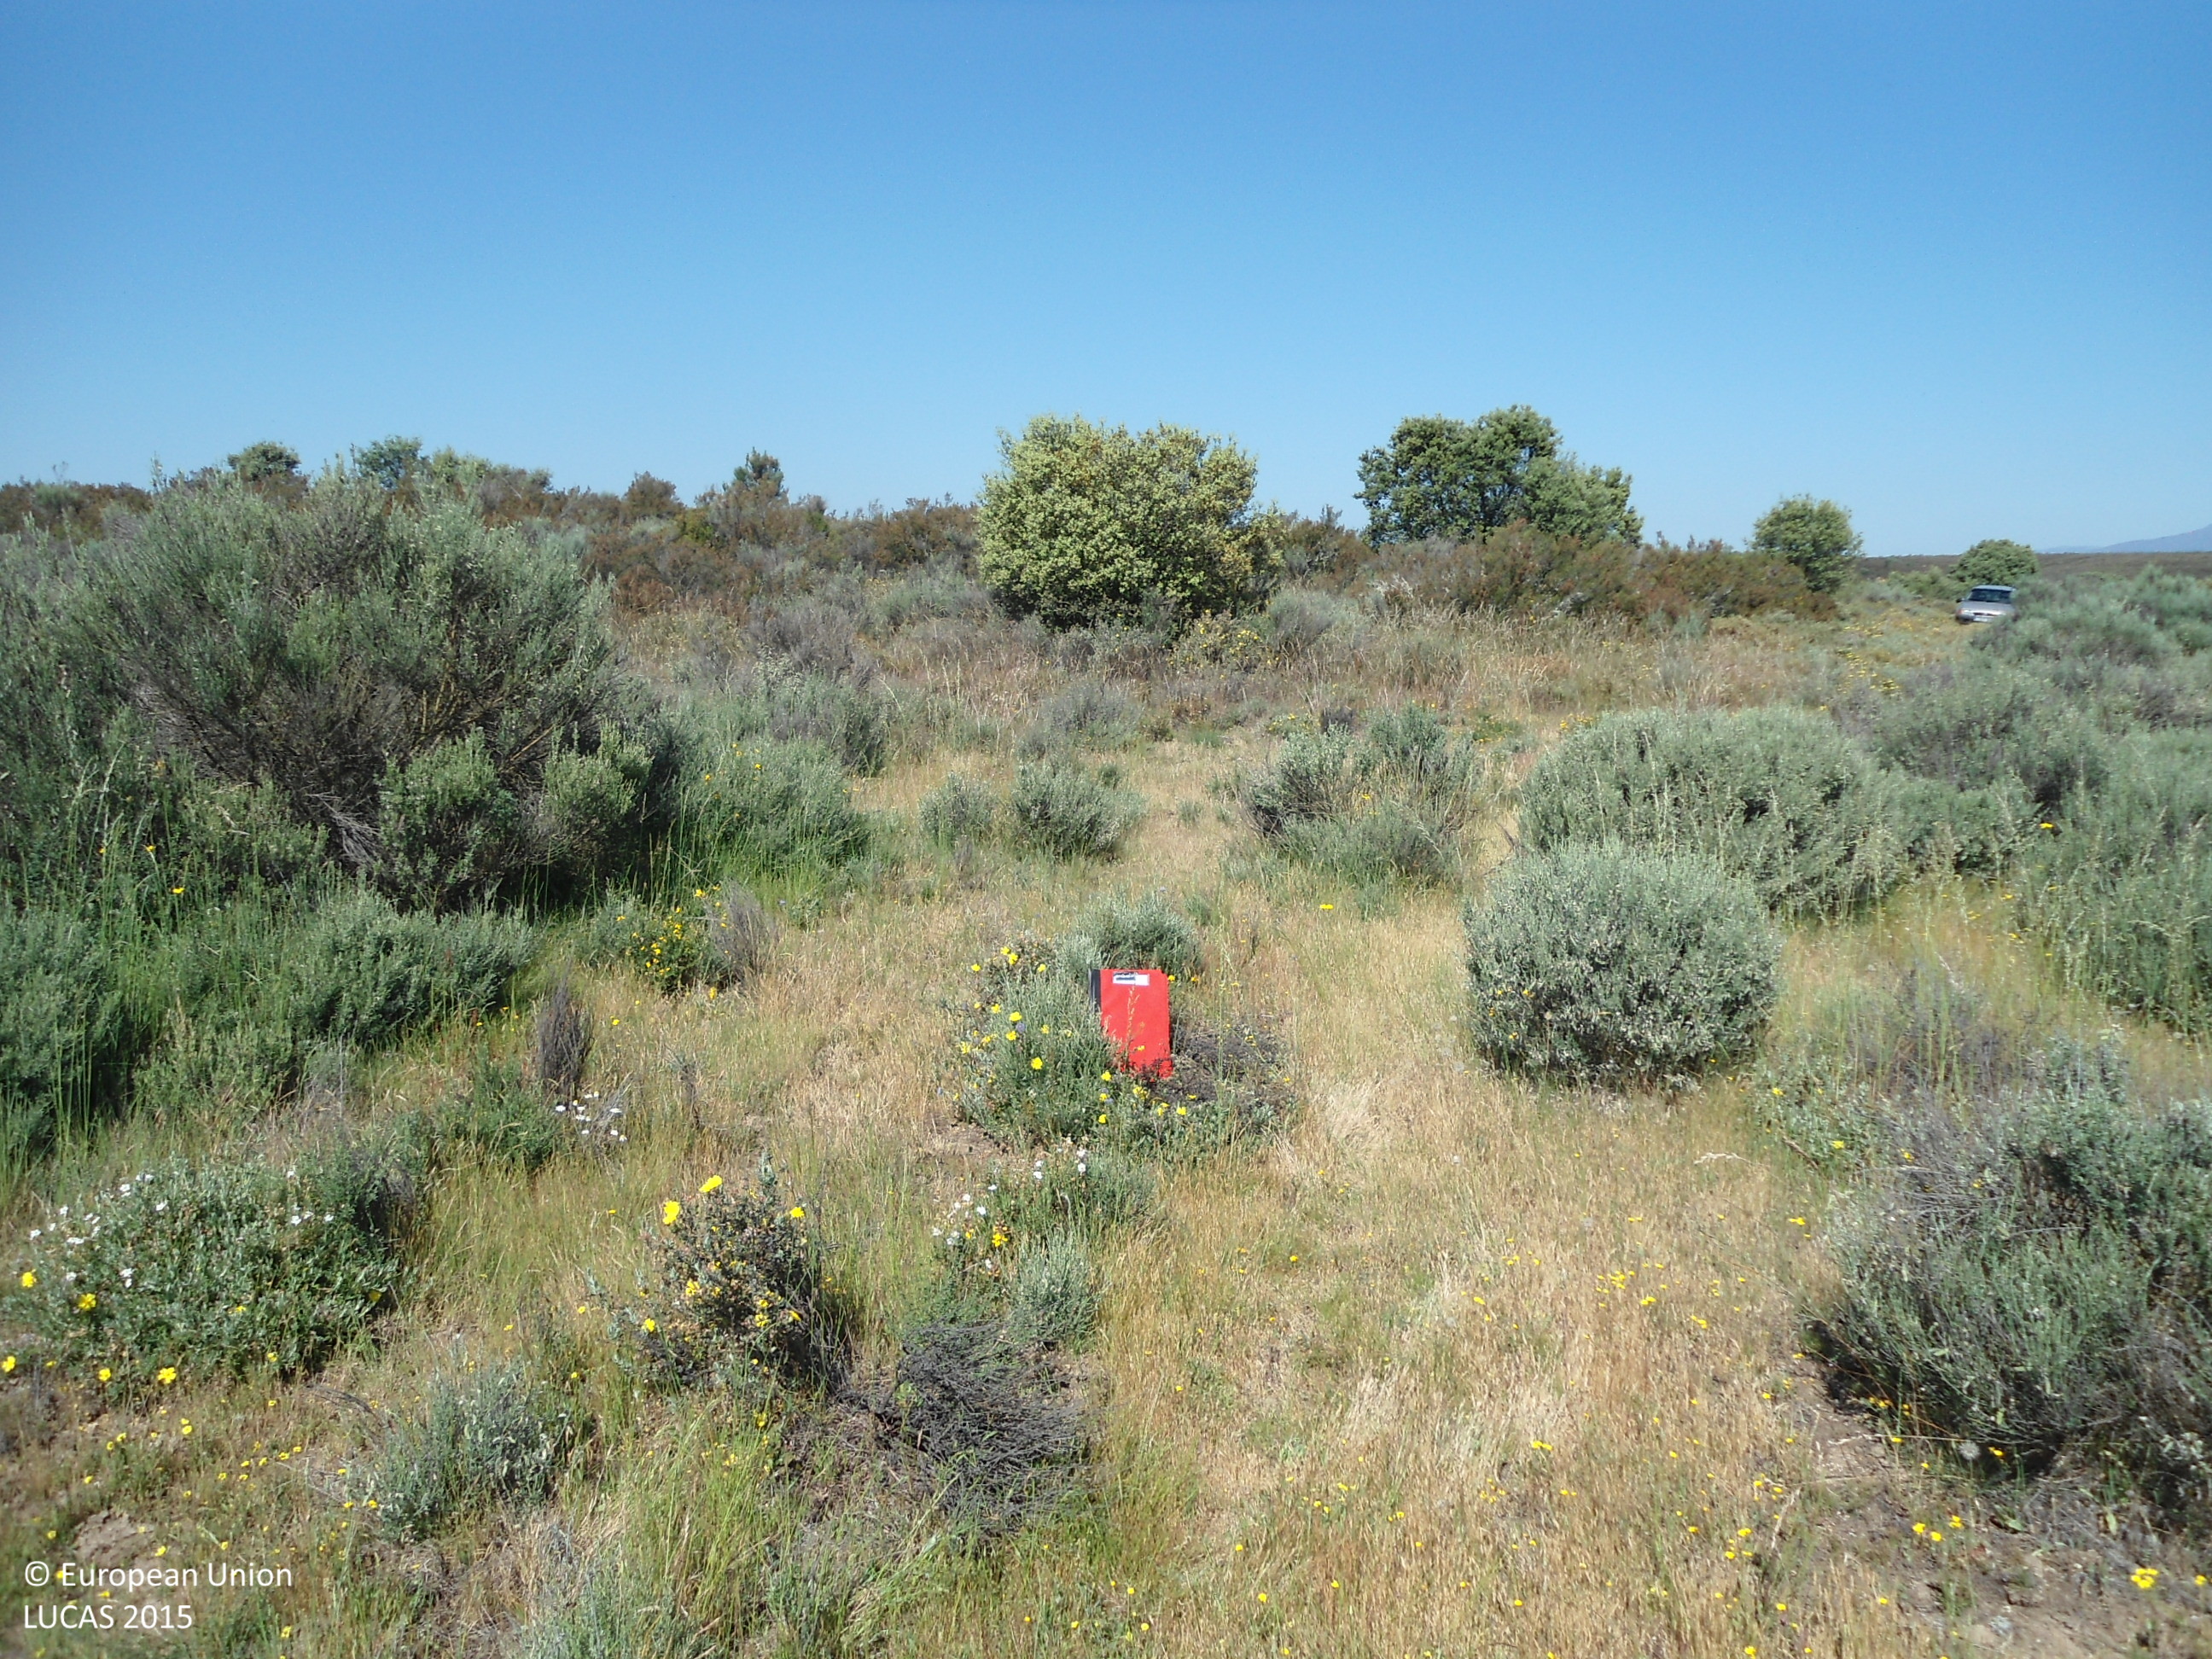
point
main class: Shrubland
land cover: Shrubland without tree cover
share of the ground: > 75 %
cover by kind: shrubs 80 %, herbaceous plants 20 %
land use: Semi-natural and natural areas not in use
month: June
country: ES
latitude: 42.0686
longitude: -6.2393
